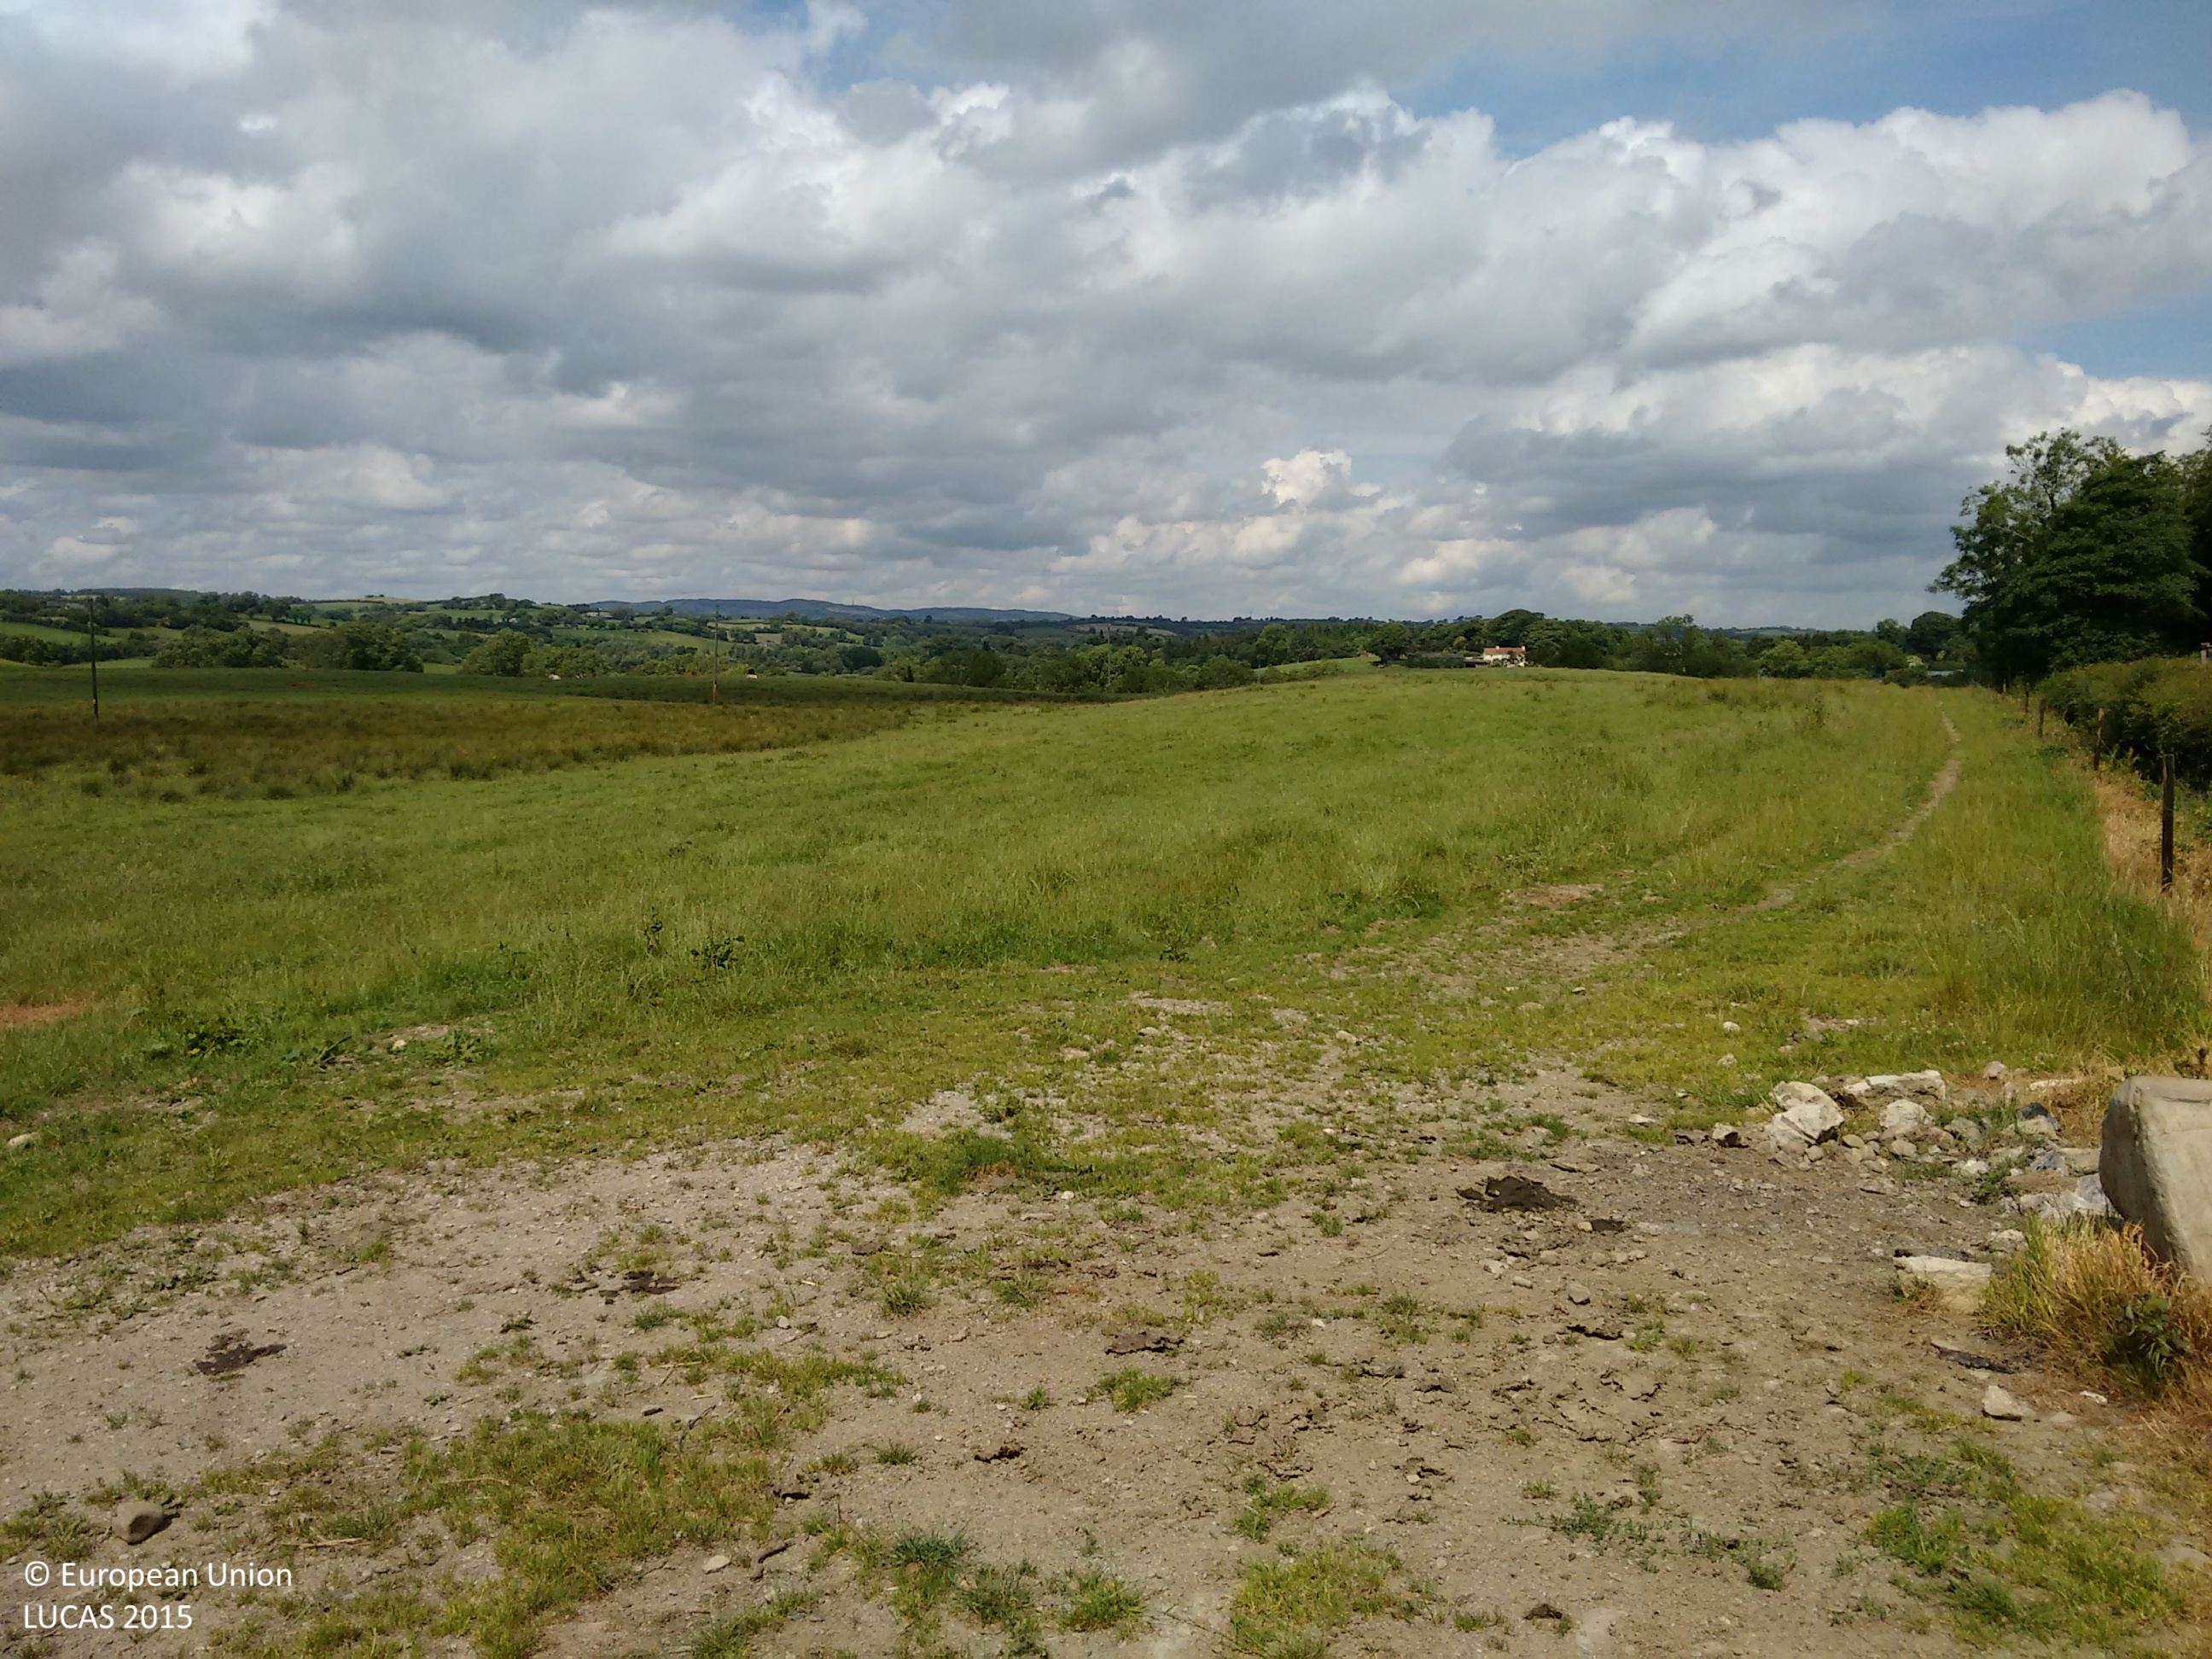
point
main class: Grassland
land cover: Grassland without tree/shrub cover
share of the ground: > 75 %
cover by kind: herbaceous plants 100 %
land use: Agriculture (excluding fallow land and kitchen gardens)
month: July
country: IE
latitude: 53.8555
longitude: -6.7817
